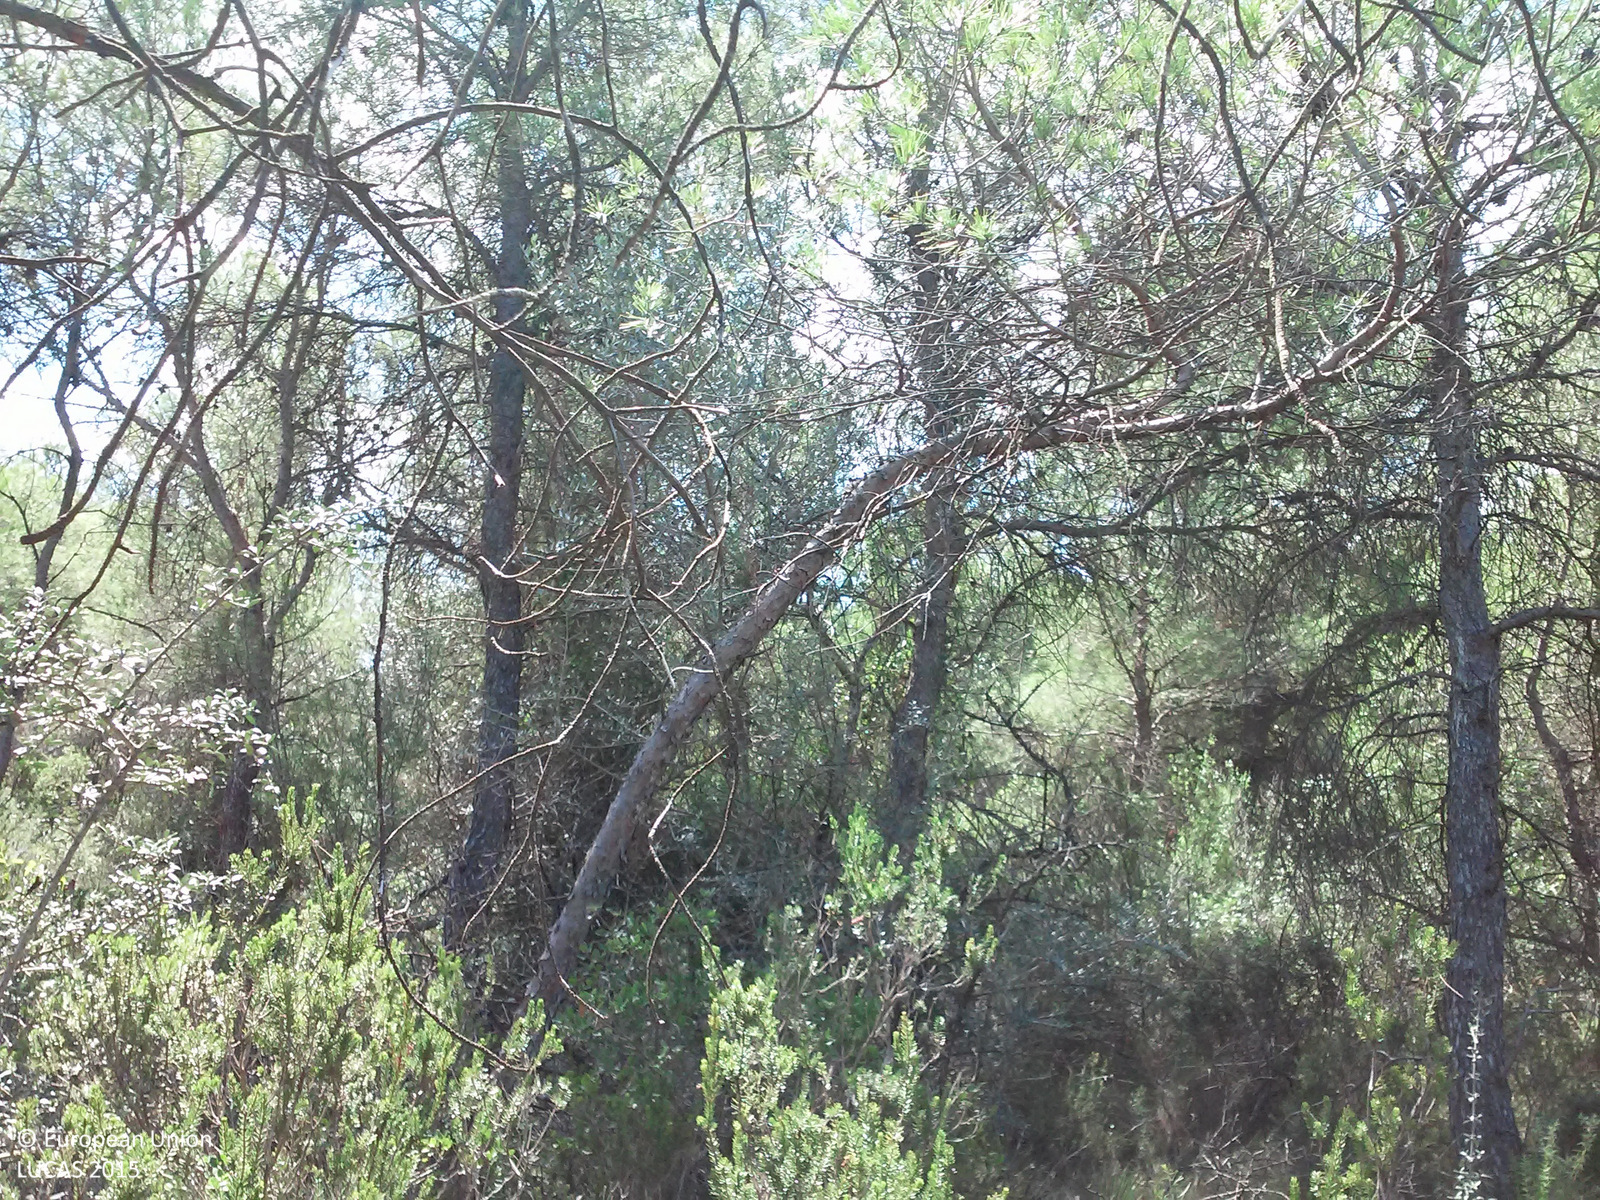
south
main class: Woodland
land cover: Pine dominated coniferous woodland
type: coniferous forest of the mediterranean region
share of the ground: 10 - 25 %
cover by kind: shrubs 60 %, coniferous forest trees 40 %
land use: Semi-natural and natural areas not in use
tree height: < 5 m
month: August
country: ES
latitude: 41.0014
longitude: 0.6363
